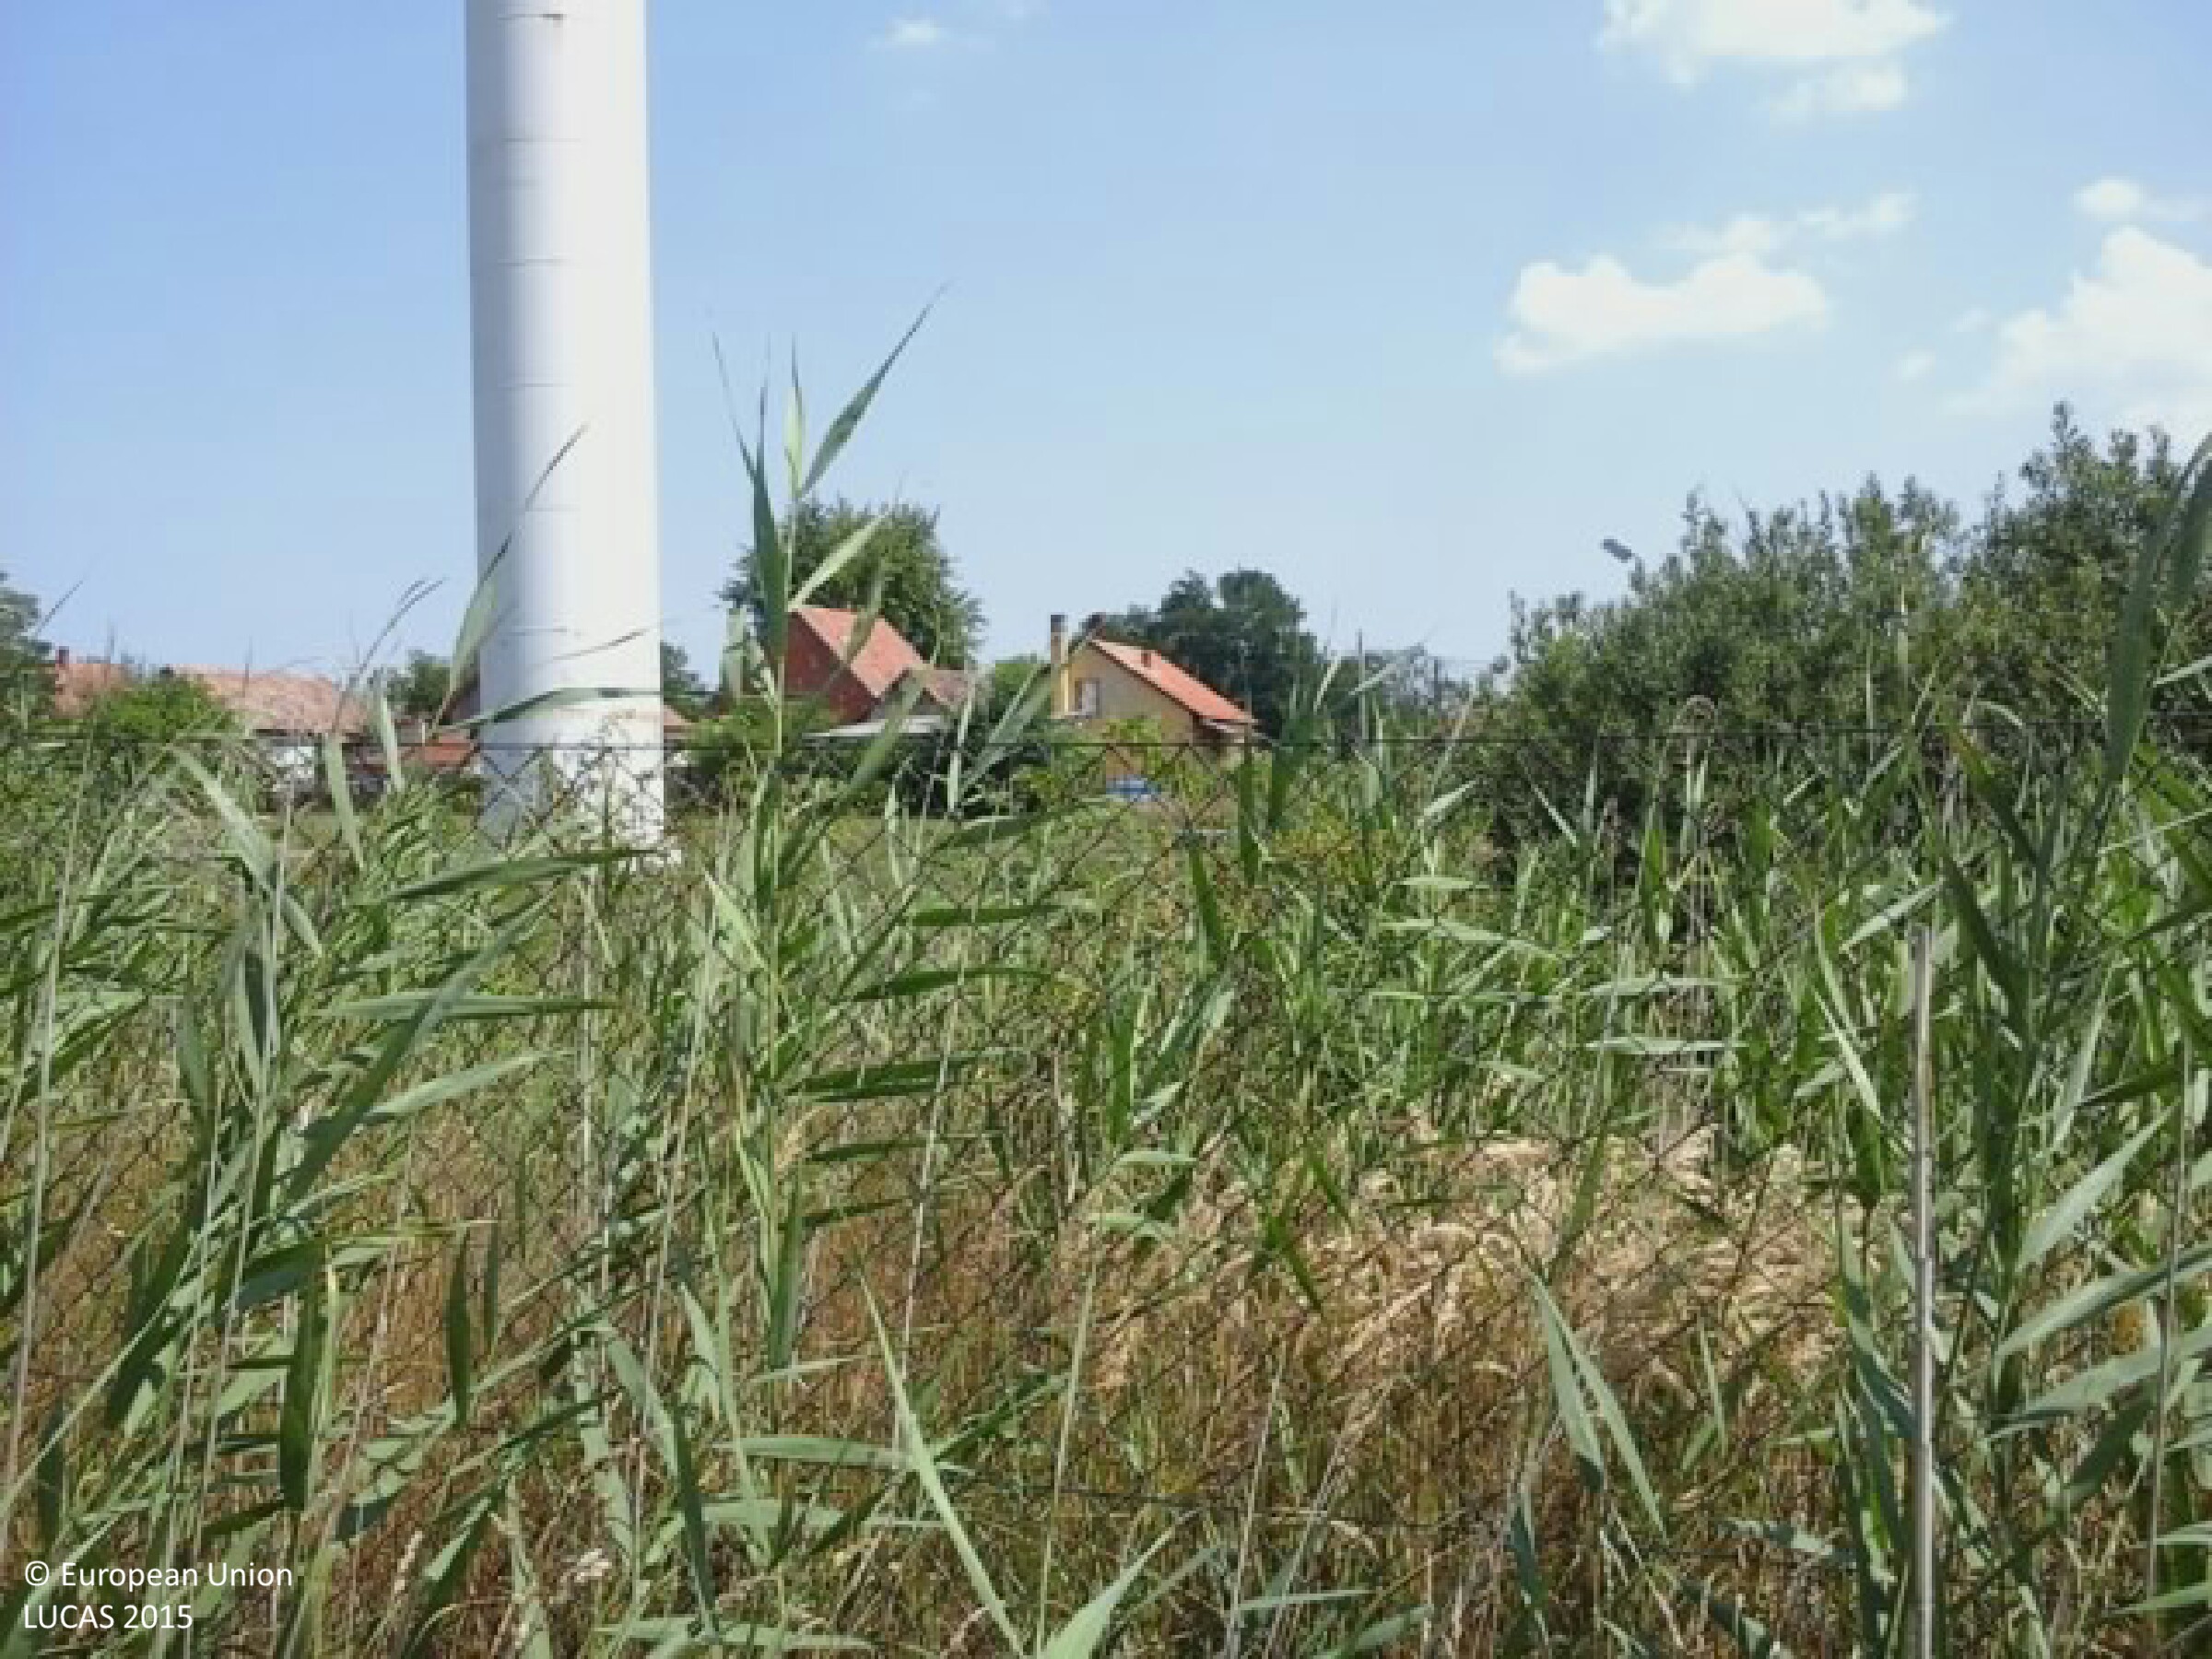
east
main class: Grassland
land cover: Grassland without tree/shrub cover
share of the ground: > 75 %
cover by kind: herbaceous plants 100 %
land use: Agriculture (excluding fallow land and kitchen gardens)
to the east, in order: Grassland without tree/shrub cover; Fences; Artificial constructions in urban areas
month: August
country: HU
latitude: 47.2448
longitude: 19.3598
